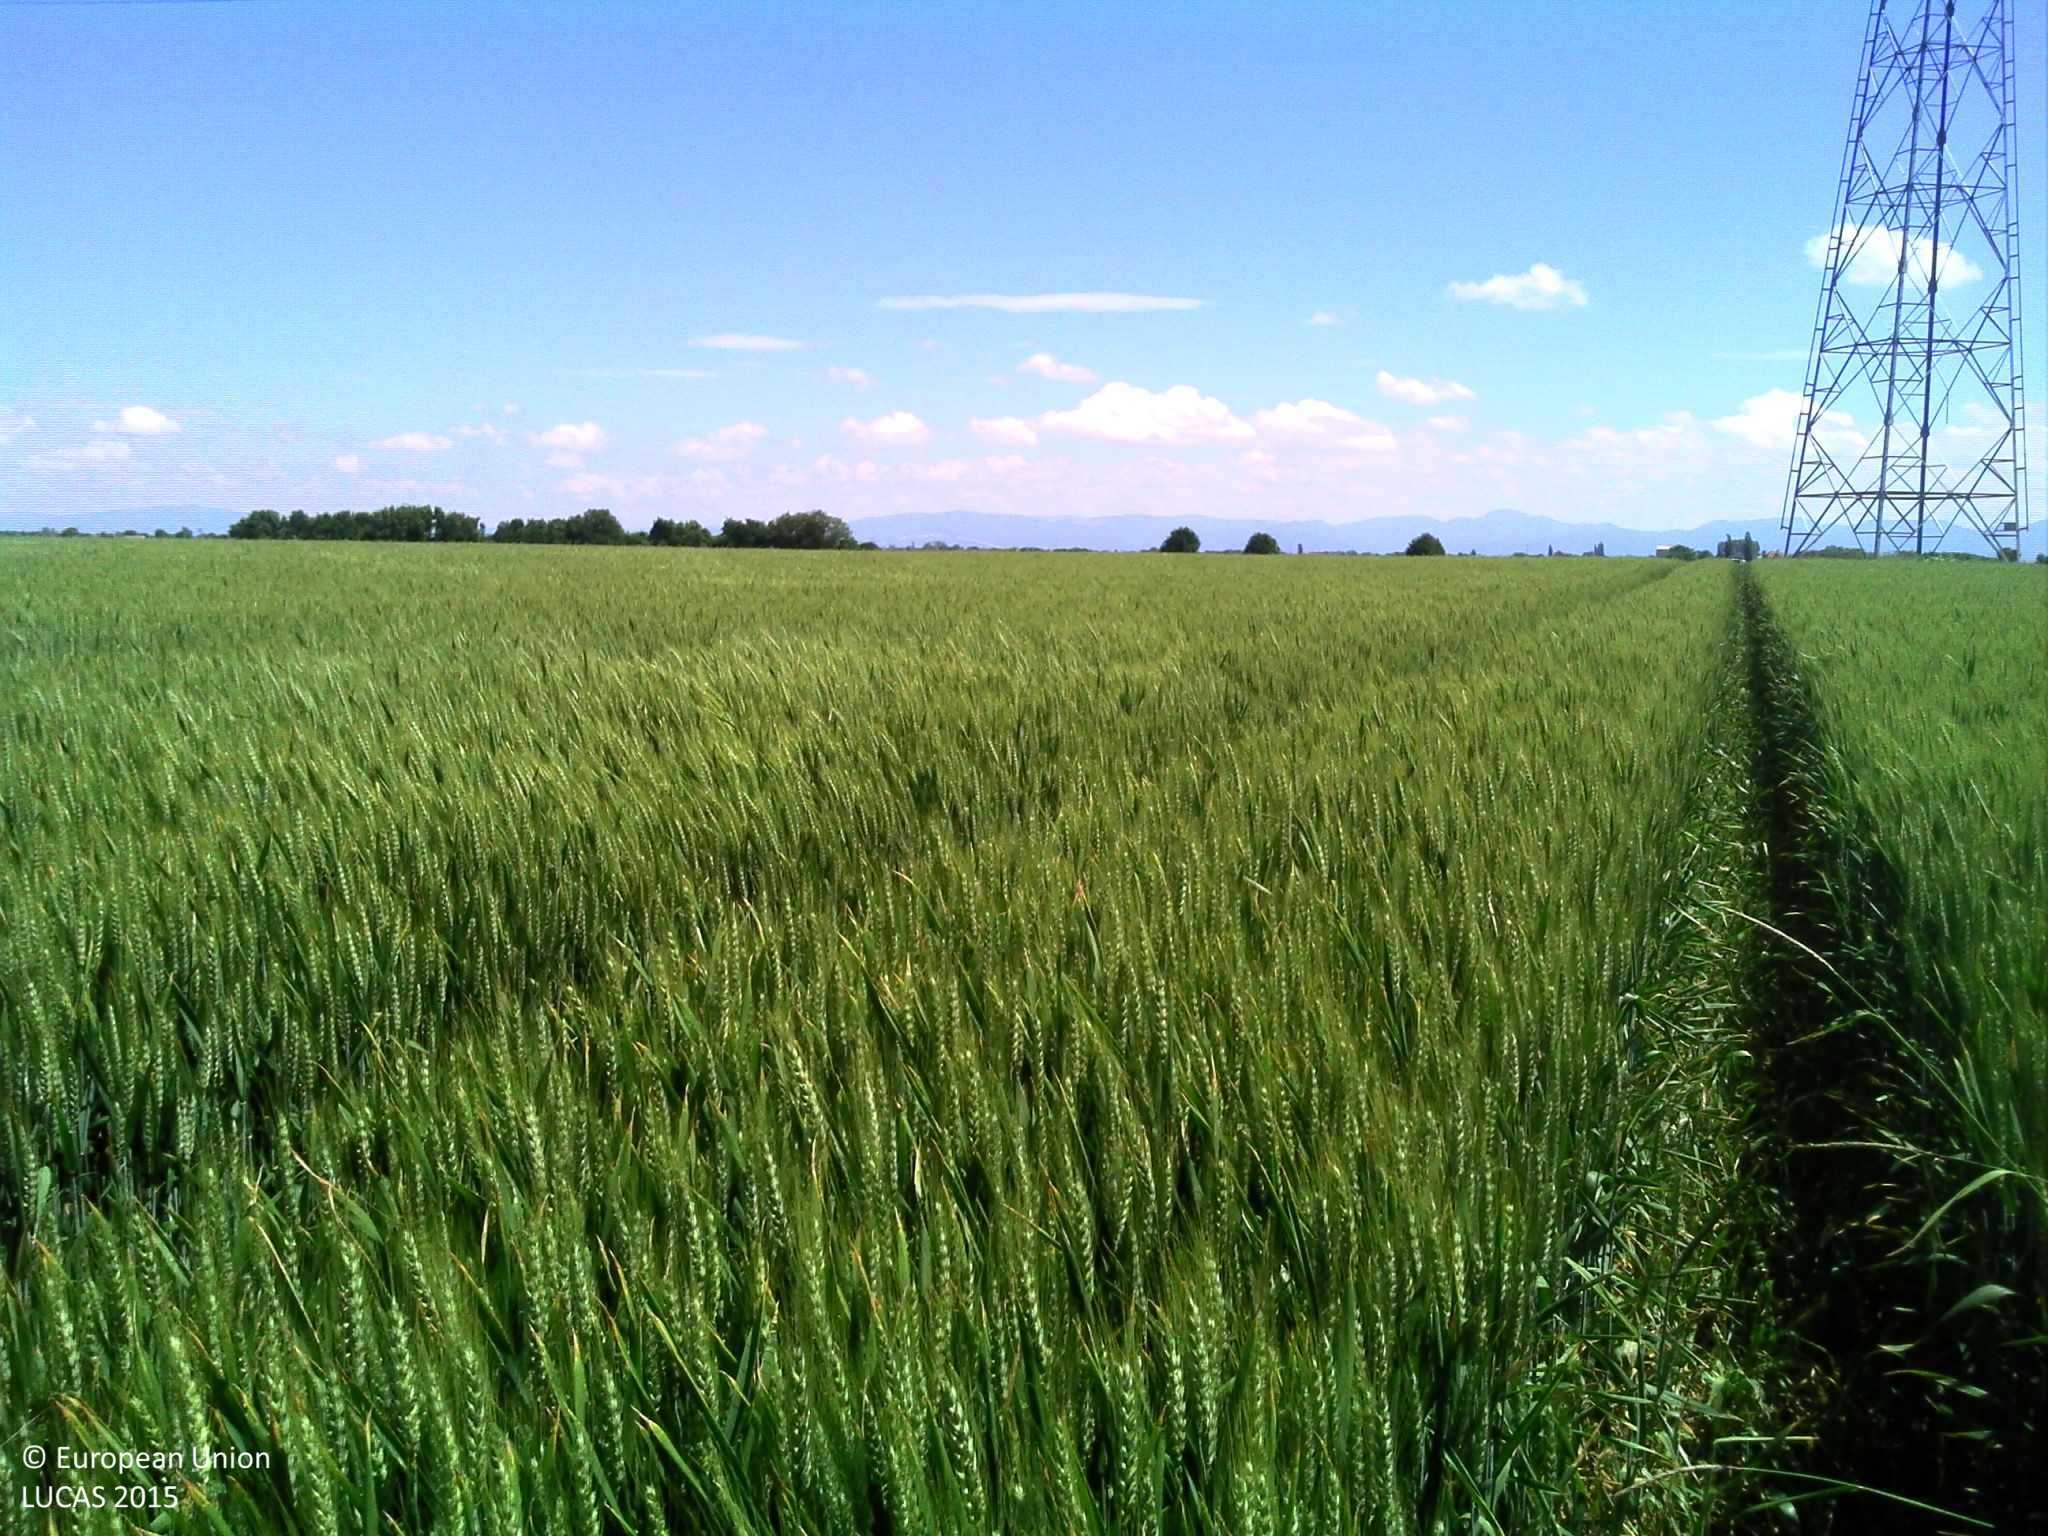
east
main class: Cropland
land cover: Common wheat
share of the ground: > 75 %
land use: Agriculture (excluding fallow land and kitchen gardens)
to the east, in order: Common wheat; Electric lines; Common wheat
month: June
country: FR
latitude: 47.9759
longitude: 7.3622
